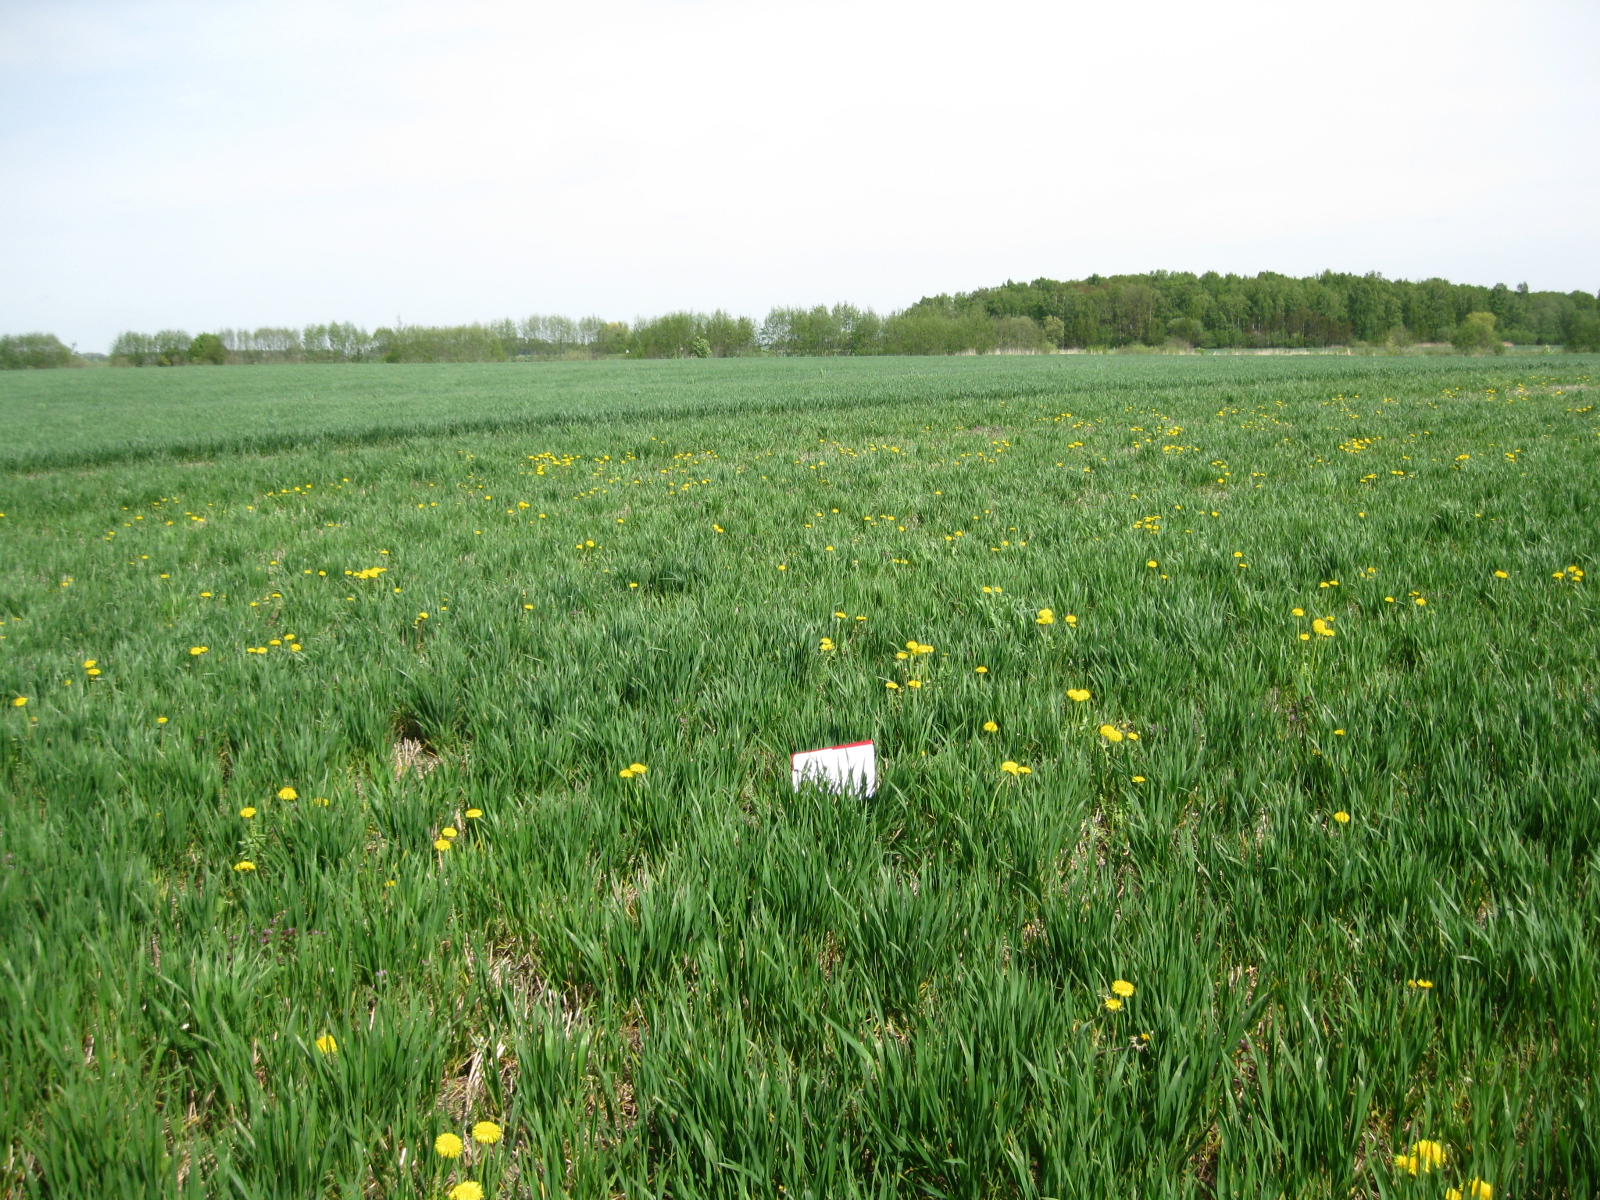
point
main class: Grassland
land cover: Grassland without tree/shrub cover
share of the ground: > 75 %
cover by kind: herbaceous plants 90 %, consolidated bare surface 10 %
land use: Agriculture (excluding fallow land and kitchen gardens)
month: May
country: LT
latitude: 56.2331
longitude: 24.2063
